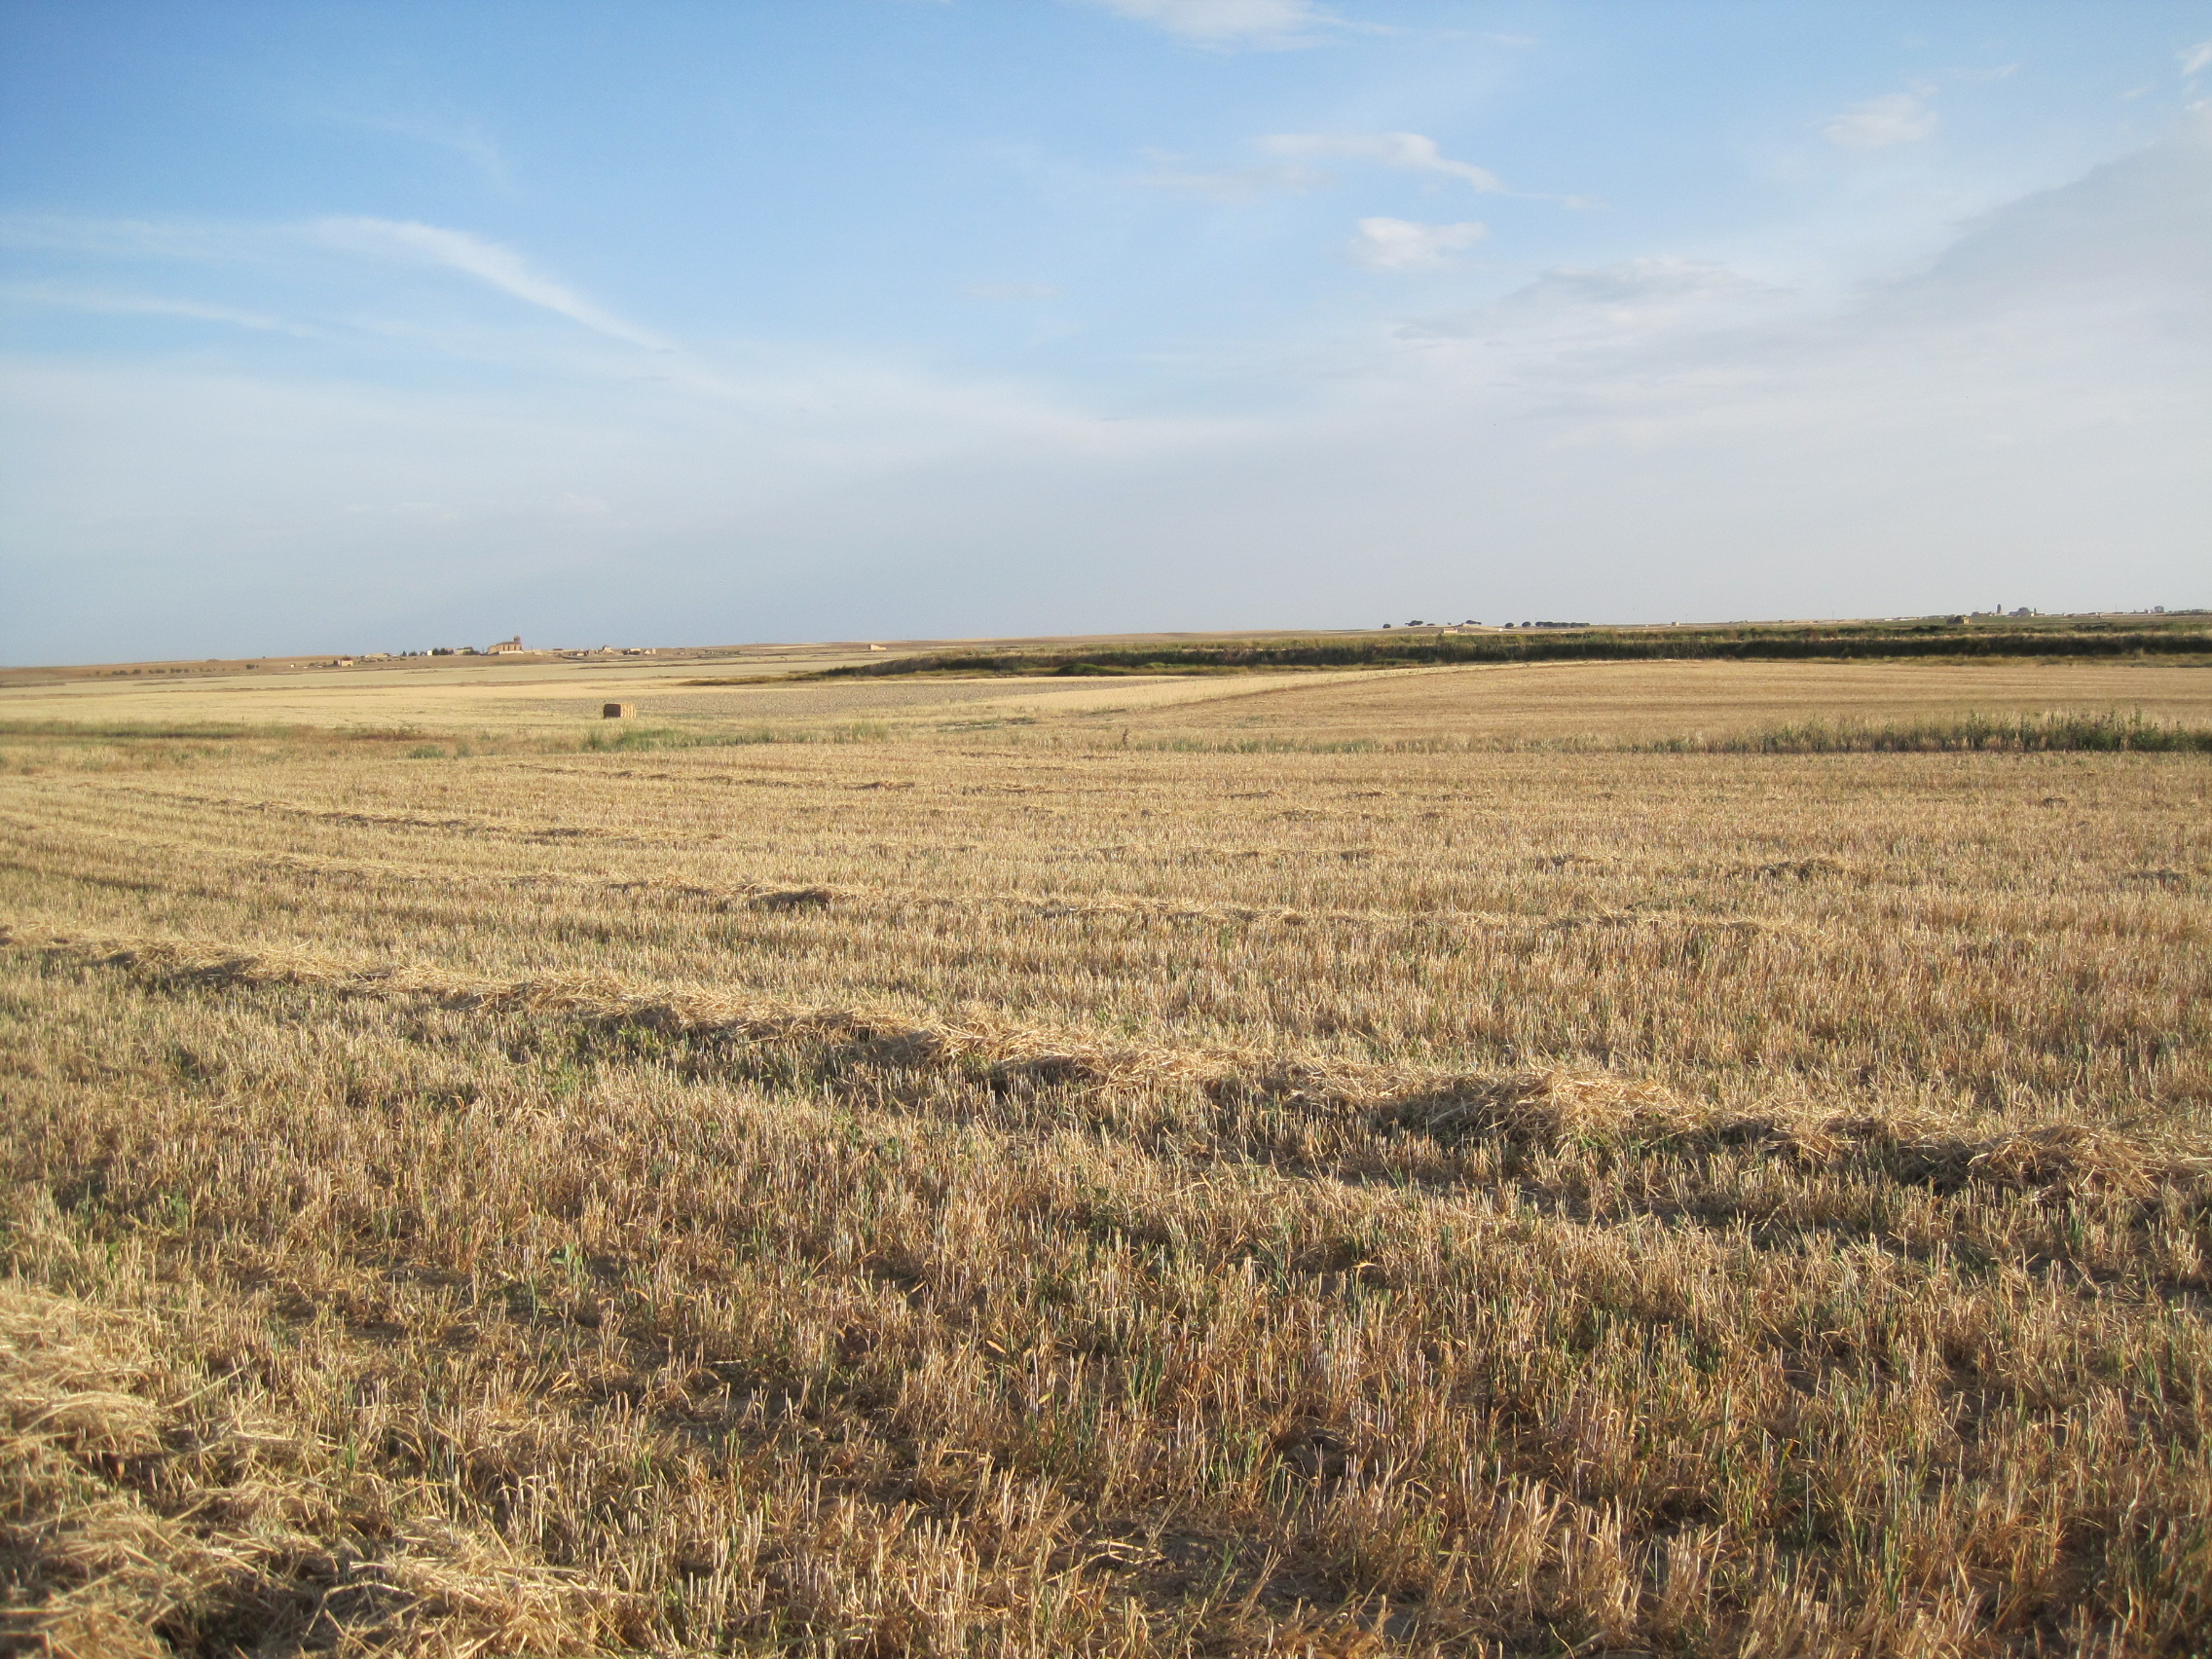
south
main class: Cropland
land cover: Barley
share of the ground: < 10 %
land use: Agriculture (excluding fallow land and kitchen gardens)
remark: Harvested field
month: July
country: ES
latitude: 41.8389
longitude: -5.6110
